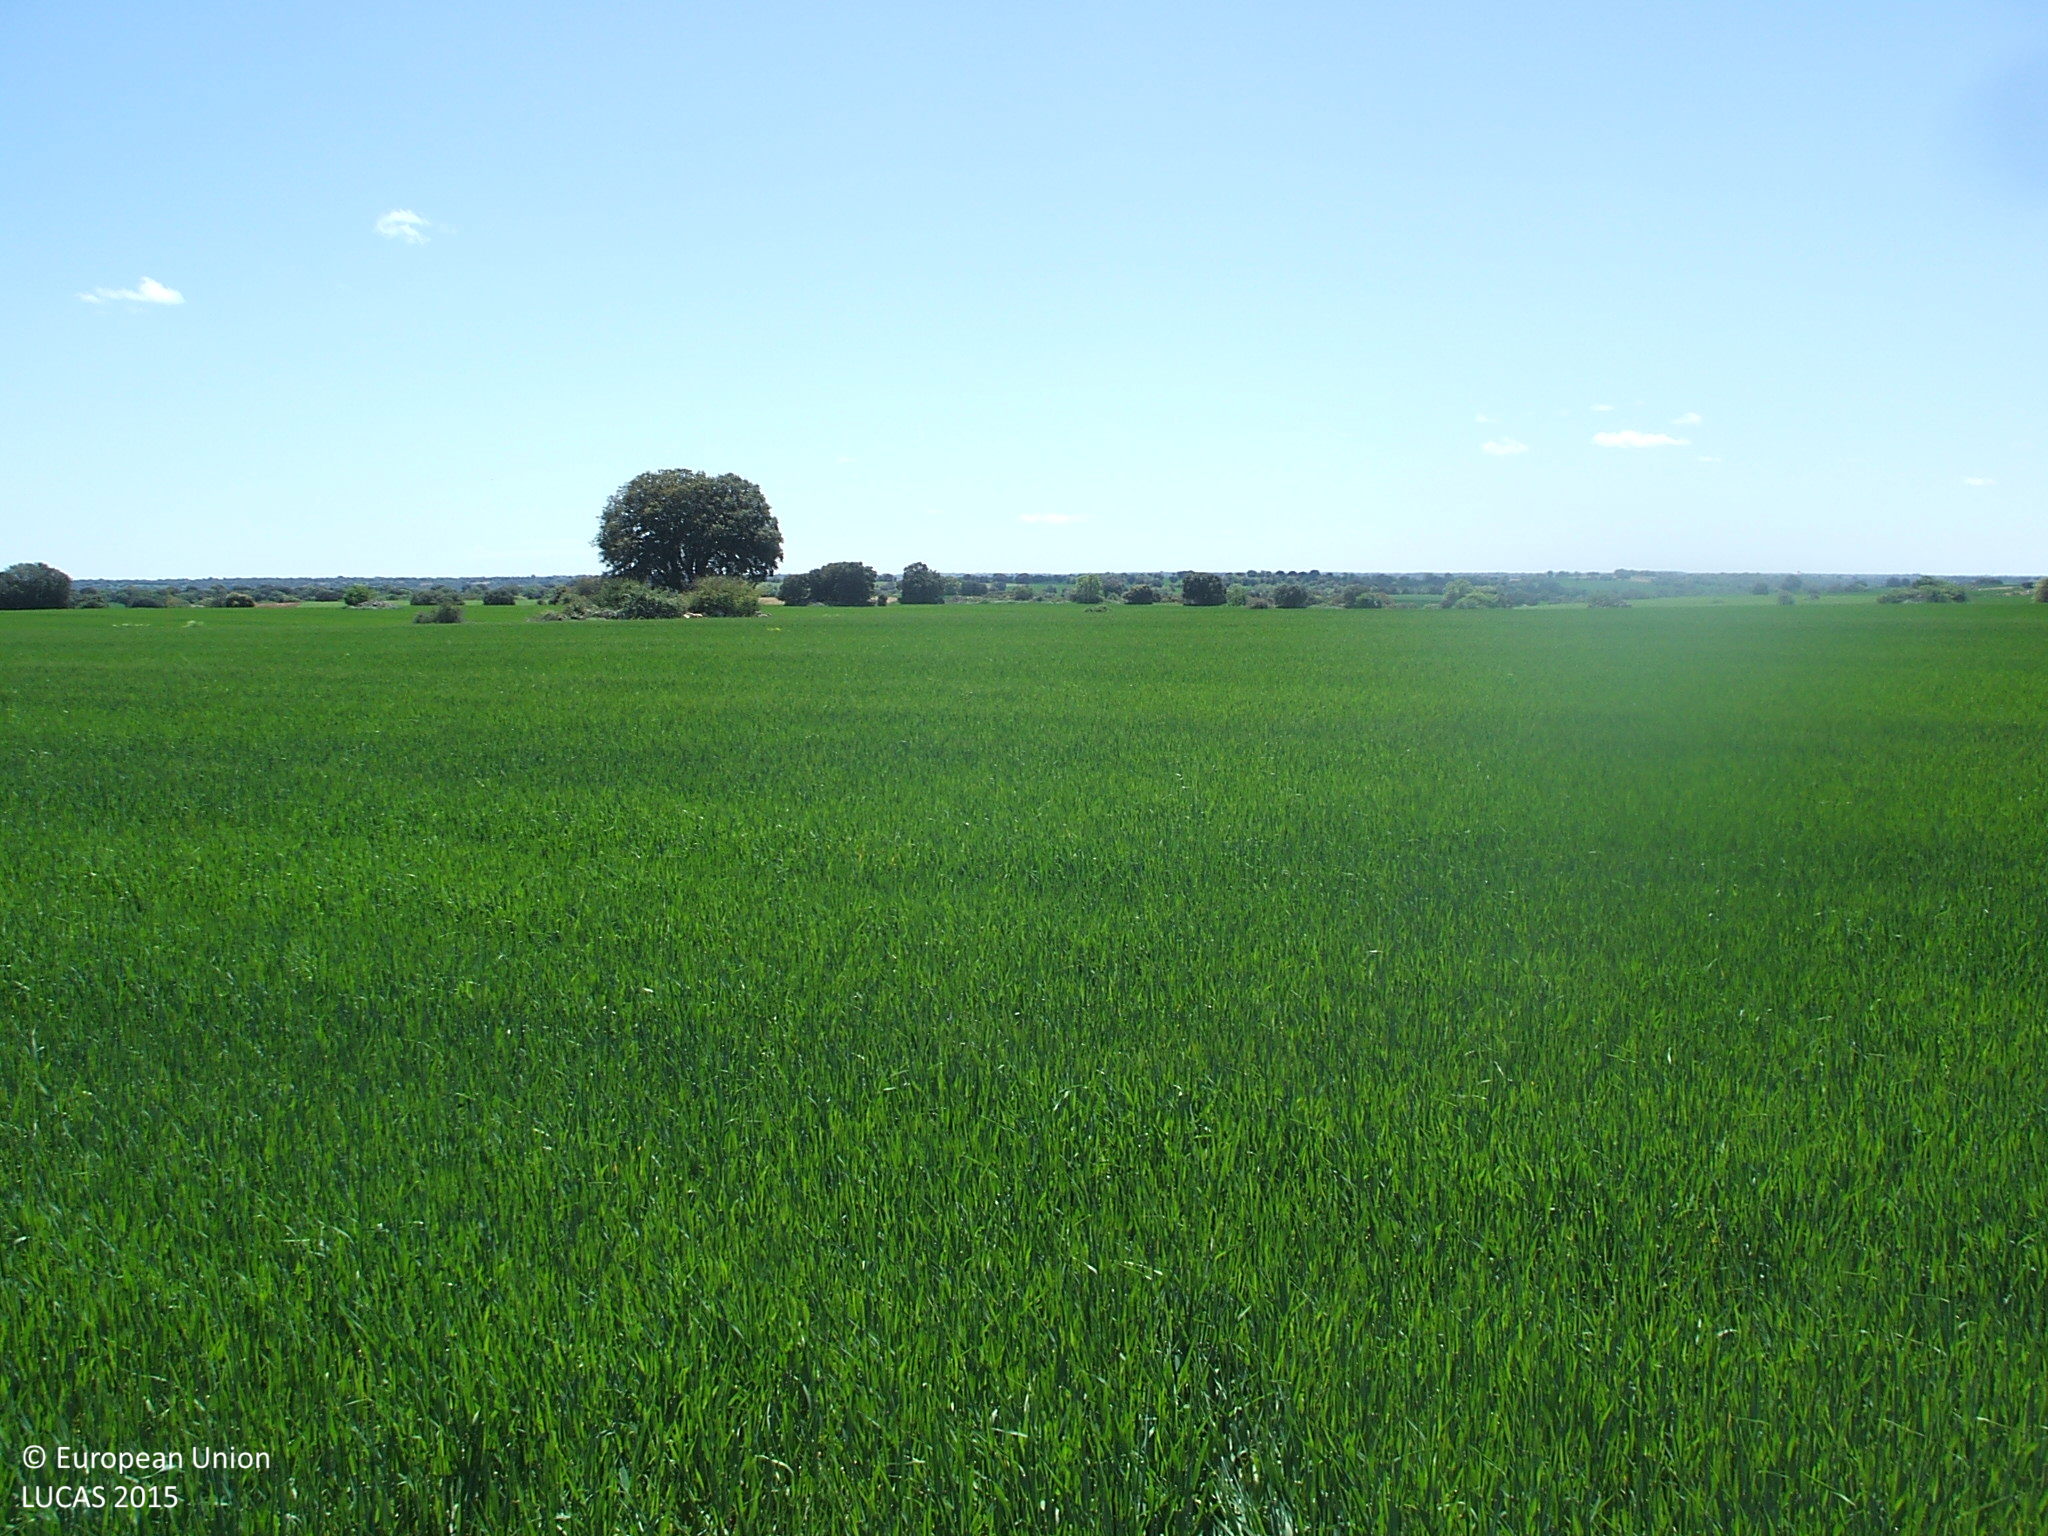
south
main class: Cropland
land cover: Barley
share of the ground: > 75 %
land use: Agriculture (excluding fallow land and kitchen gardens)
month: May
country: ES
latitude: 40.7047
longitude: -2.9445
